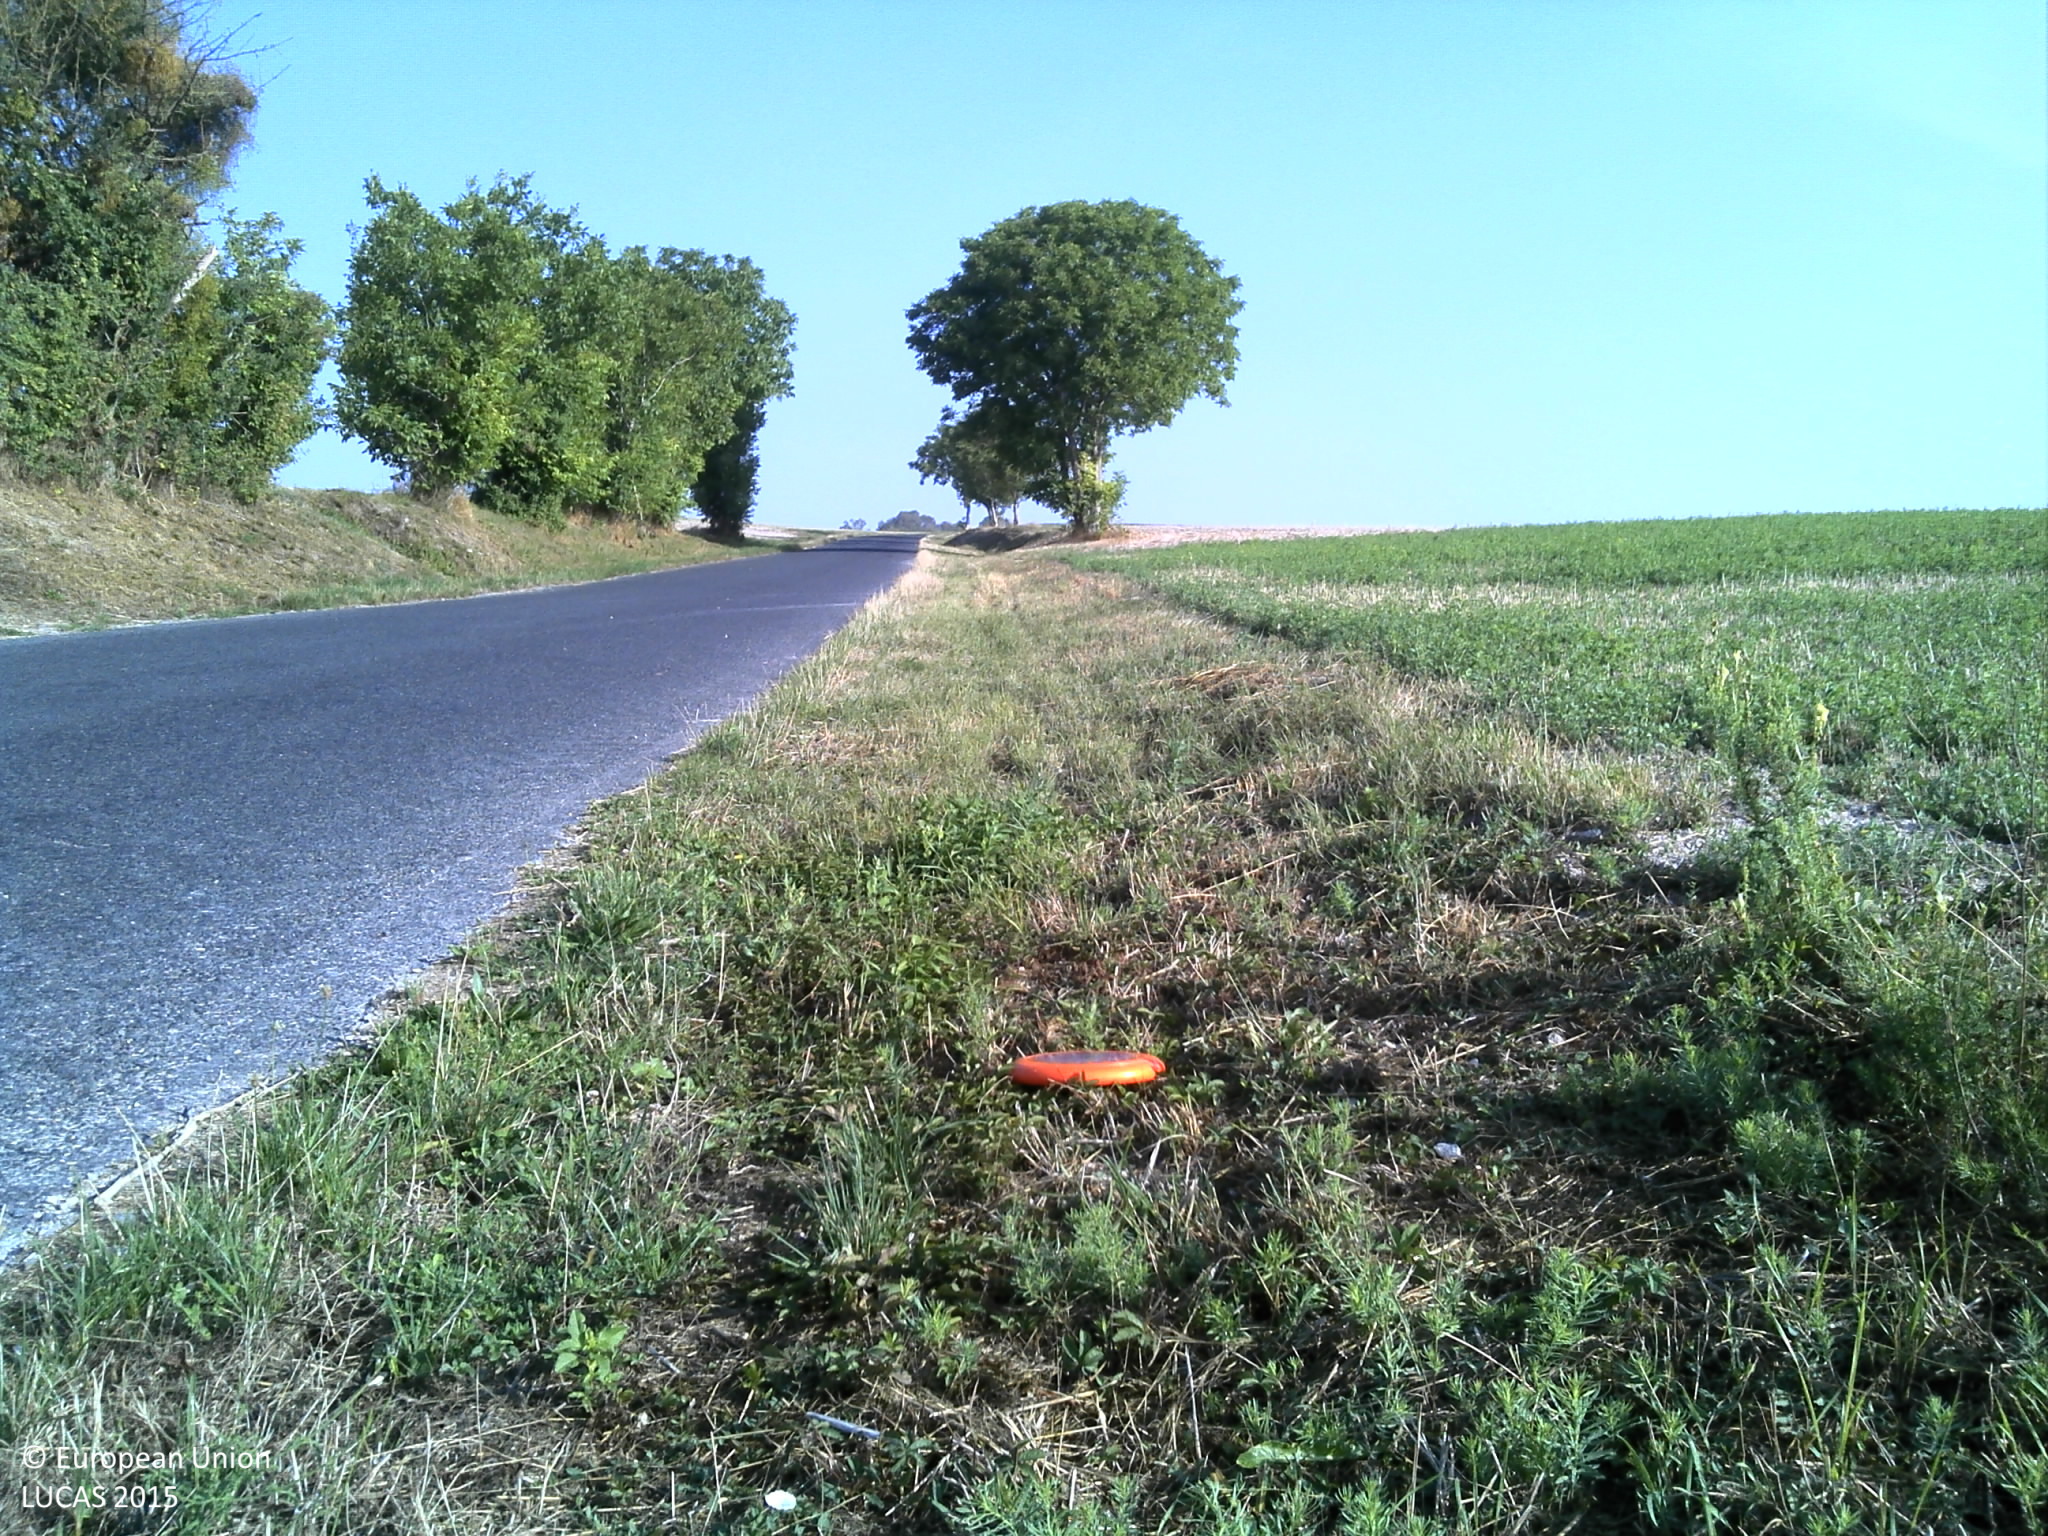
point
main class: Cropland
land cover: Lucerne
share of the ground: > 75 %
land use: Agriculture (excluding fallow land and kitchen gardens)
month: August
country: FR
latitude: 48.9004
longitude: 4.5539
